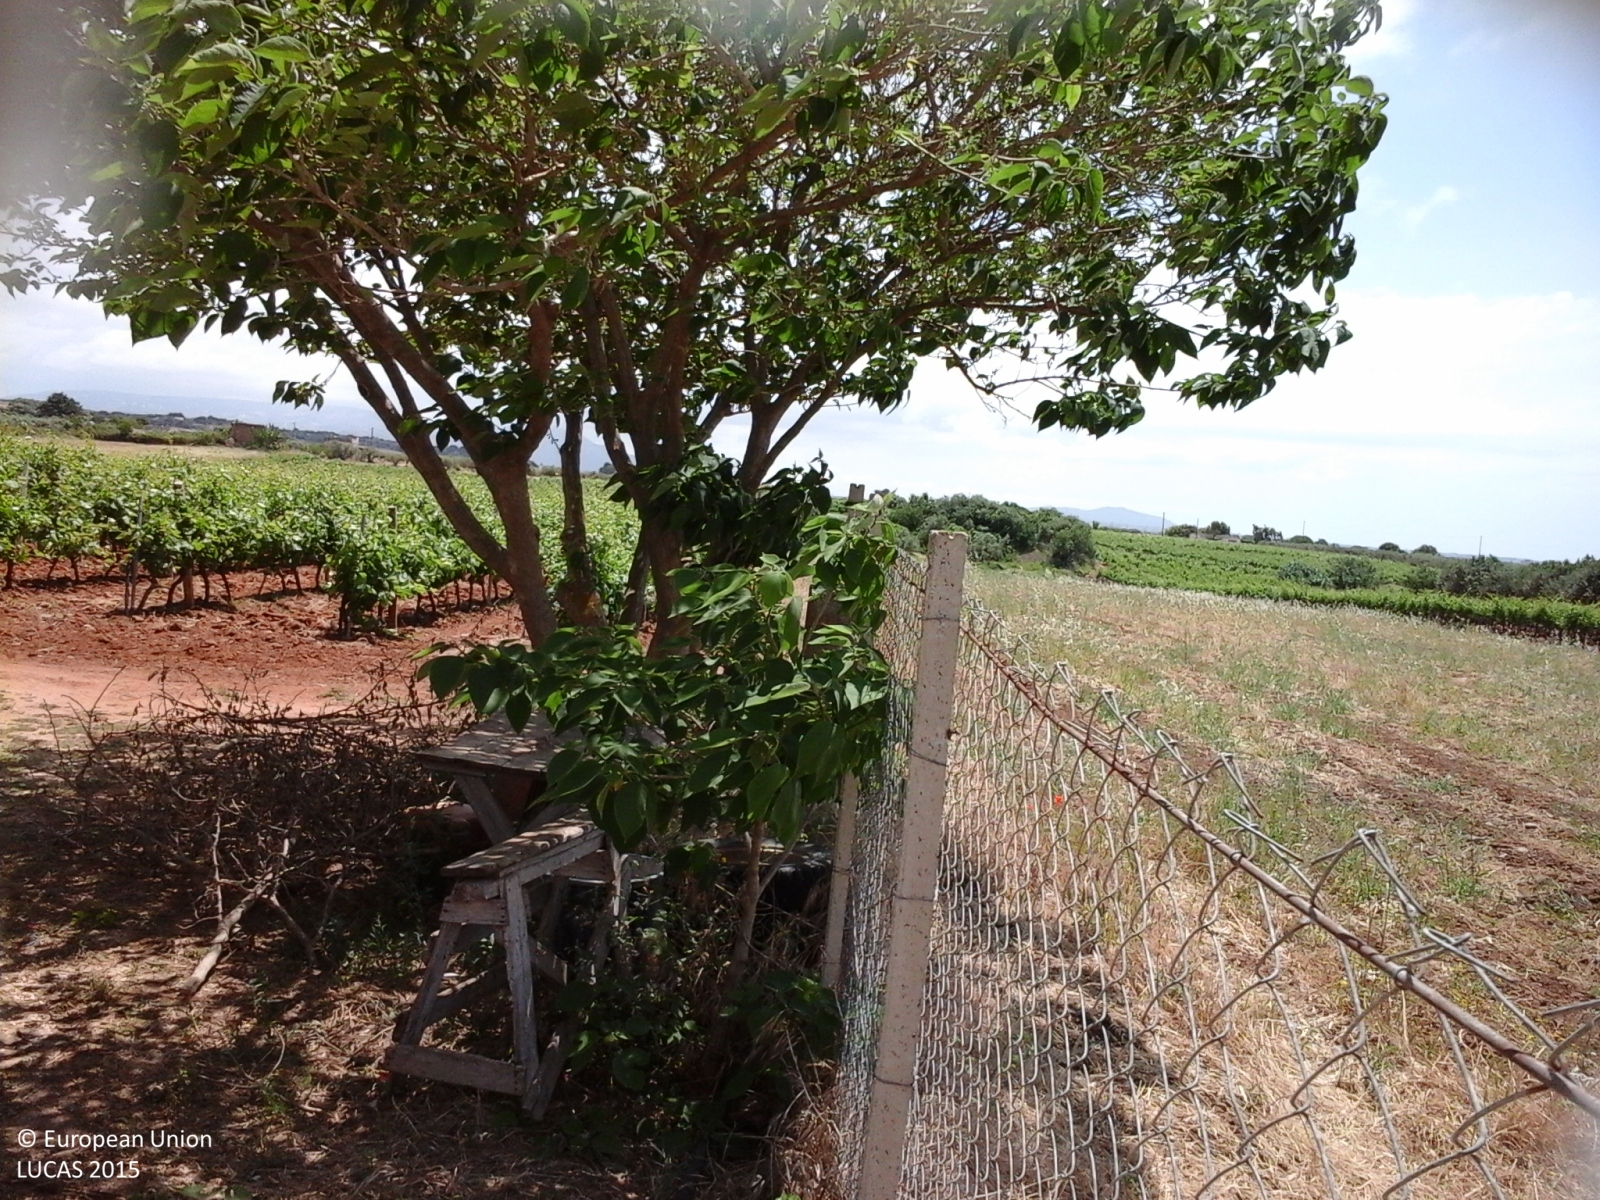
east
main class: Grassland
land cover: Spontaneously vegetated surfaces
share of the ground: > 75 %
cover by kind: herbaceous plants 100 %
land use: Fallow land
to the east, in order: Spontaneously vegetated surfaces; Fences; Vineyards; Durum wheat
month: May
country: IT
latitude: 37.6296
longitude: 12.9352
